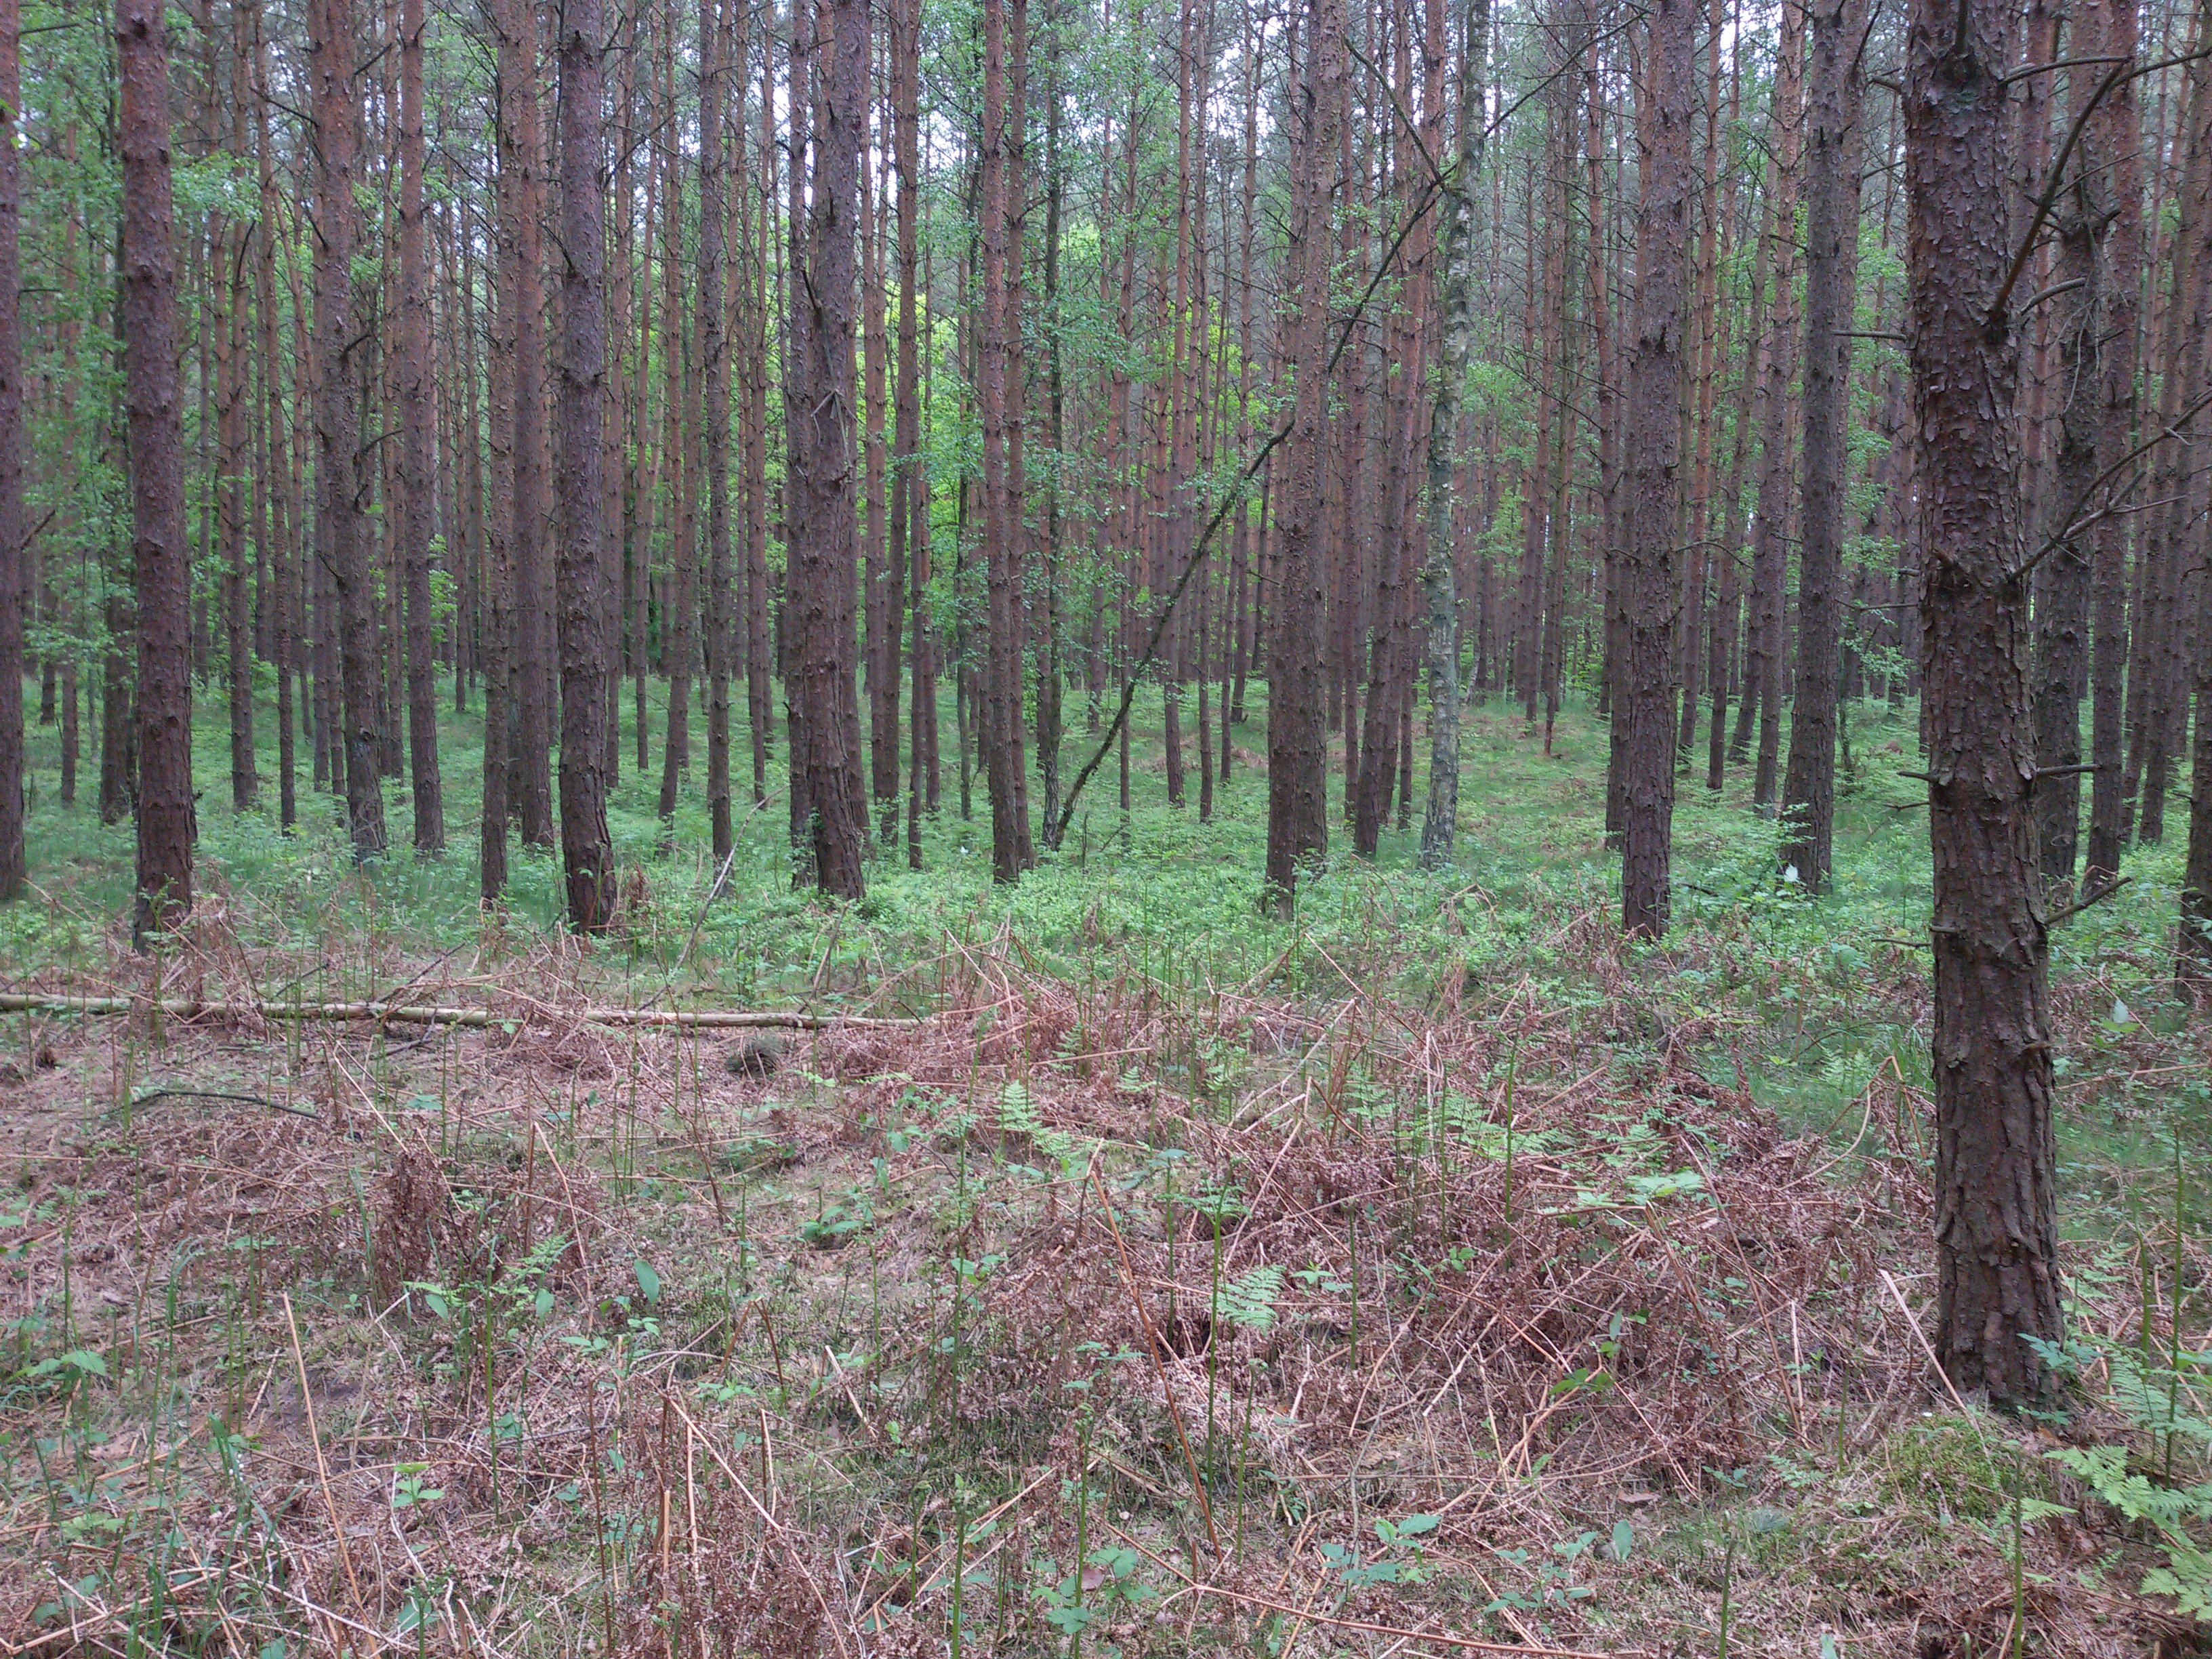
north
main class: Woodland
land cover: Pine dominated coniferous woodland
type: hemiboreal forest and nemoral coniferous forest and mixed broadleaved-coniferous forest
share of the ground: > 75 %
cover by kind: coniferous forest trees 85 %, broadleaved forest trees 5 %, herbaceous plants 5 %, lichens and mosses 5 %
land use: Forestry
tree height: > 5 m
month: May
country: PL
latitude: 53.6269
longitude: 14.4312
